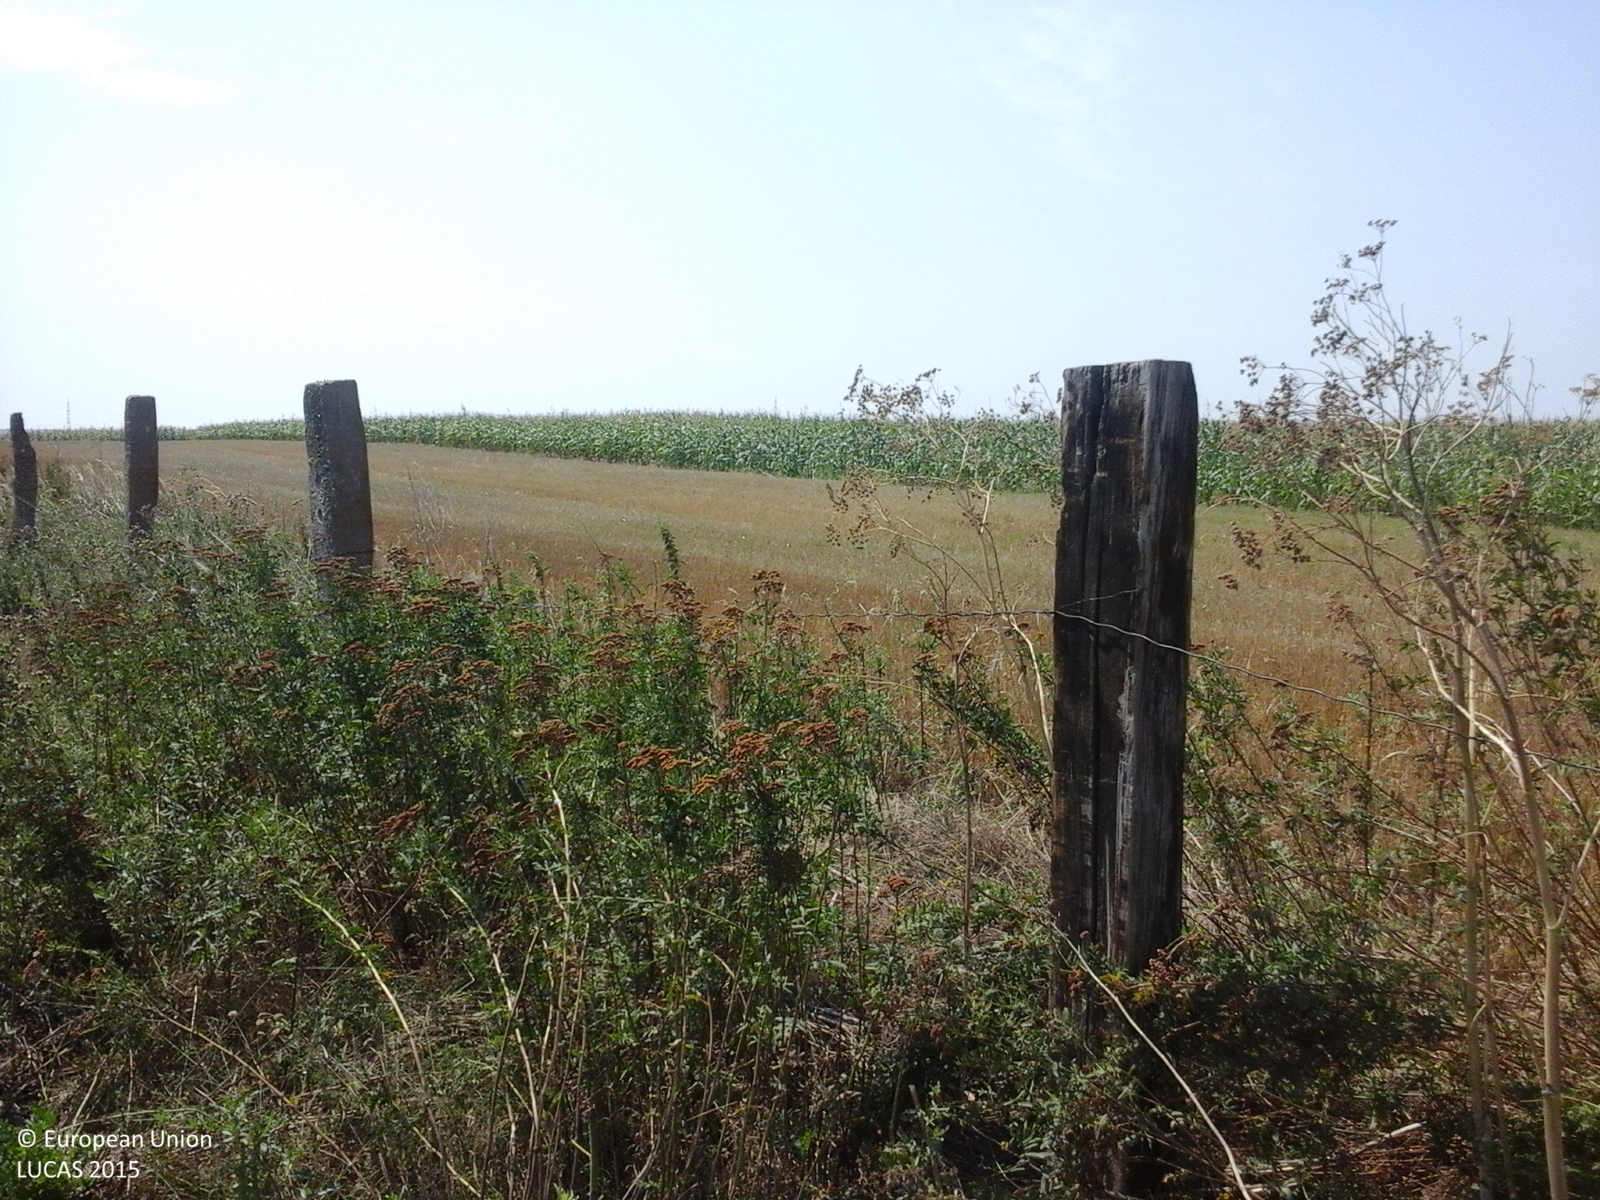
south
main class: Cropland
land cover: Maize
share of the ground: > 75 %
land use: Agriculture (excluding fallow land and kitchen gardens)
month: August
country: RO
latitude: 46.1919
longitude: 27.1096
